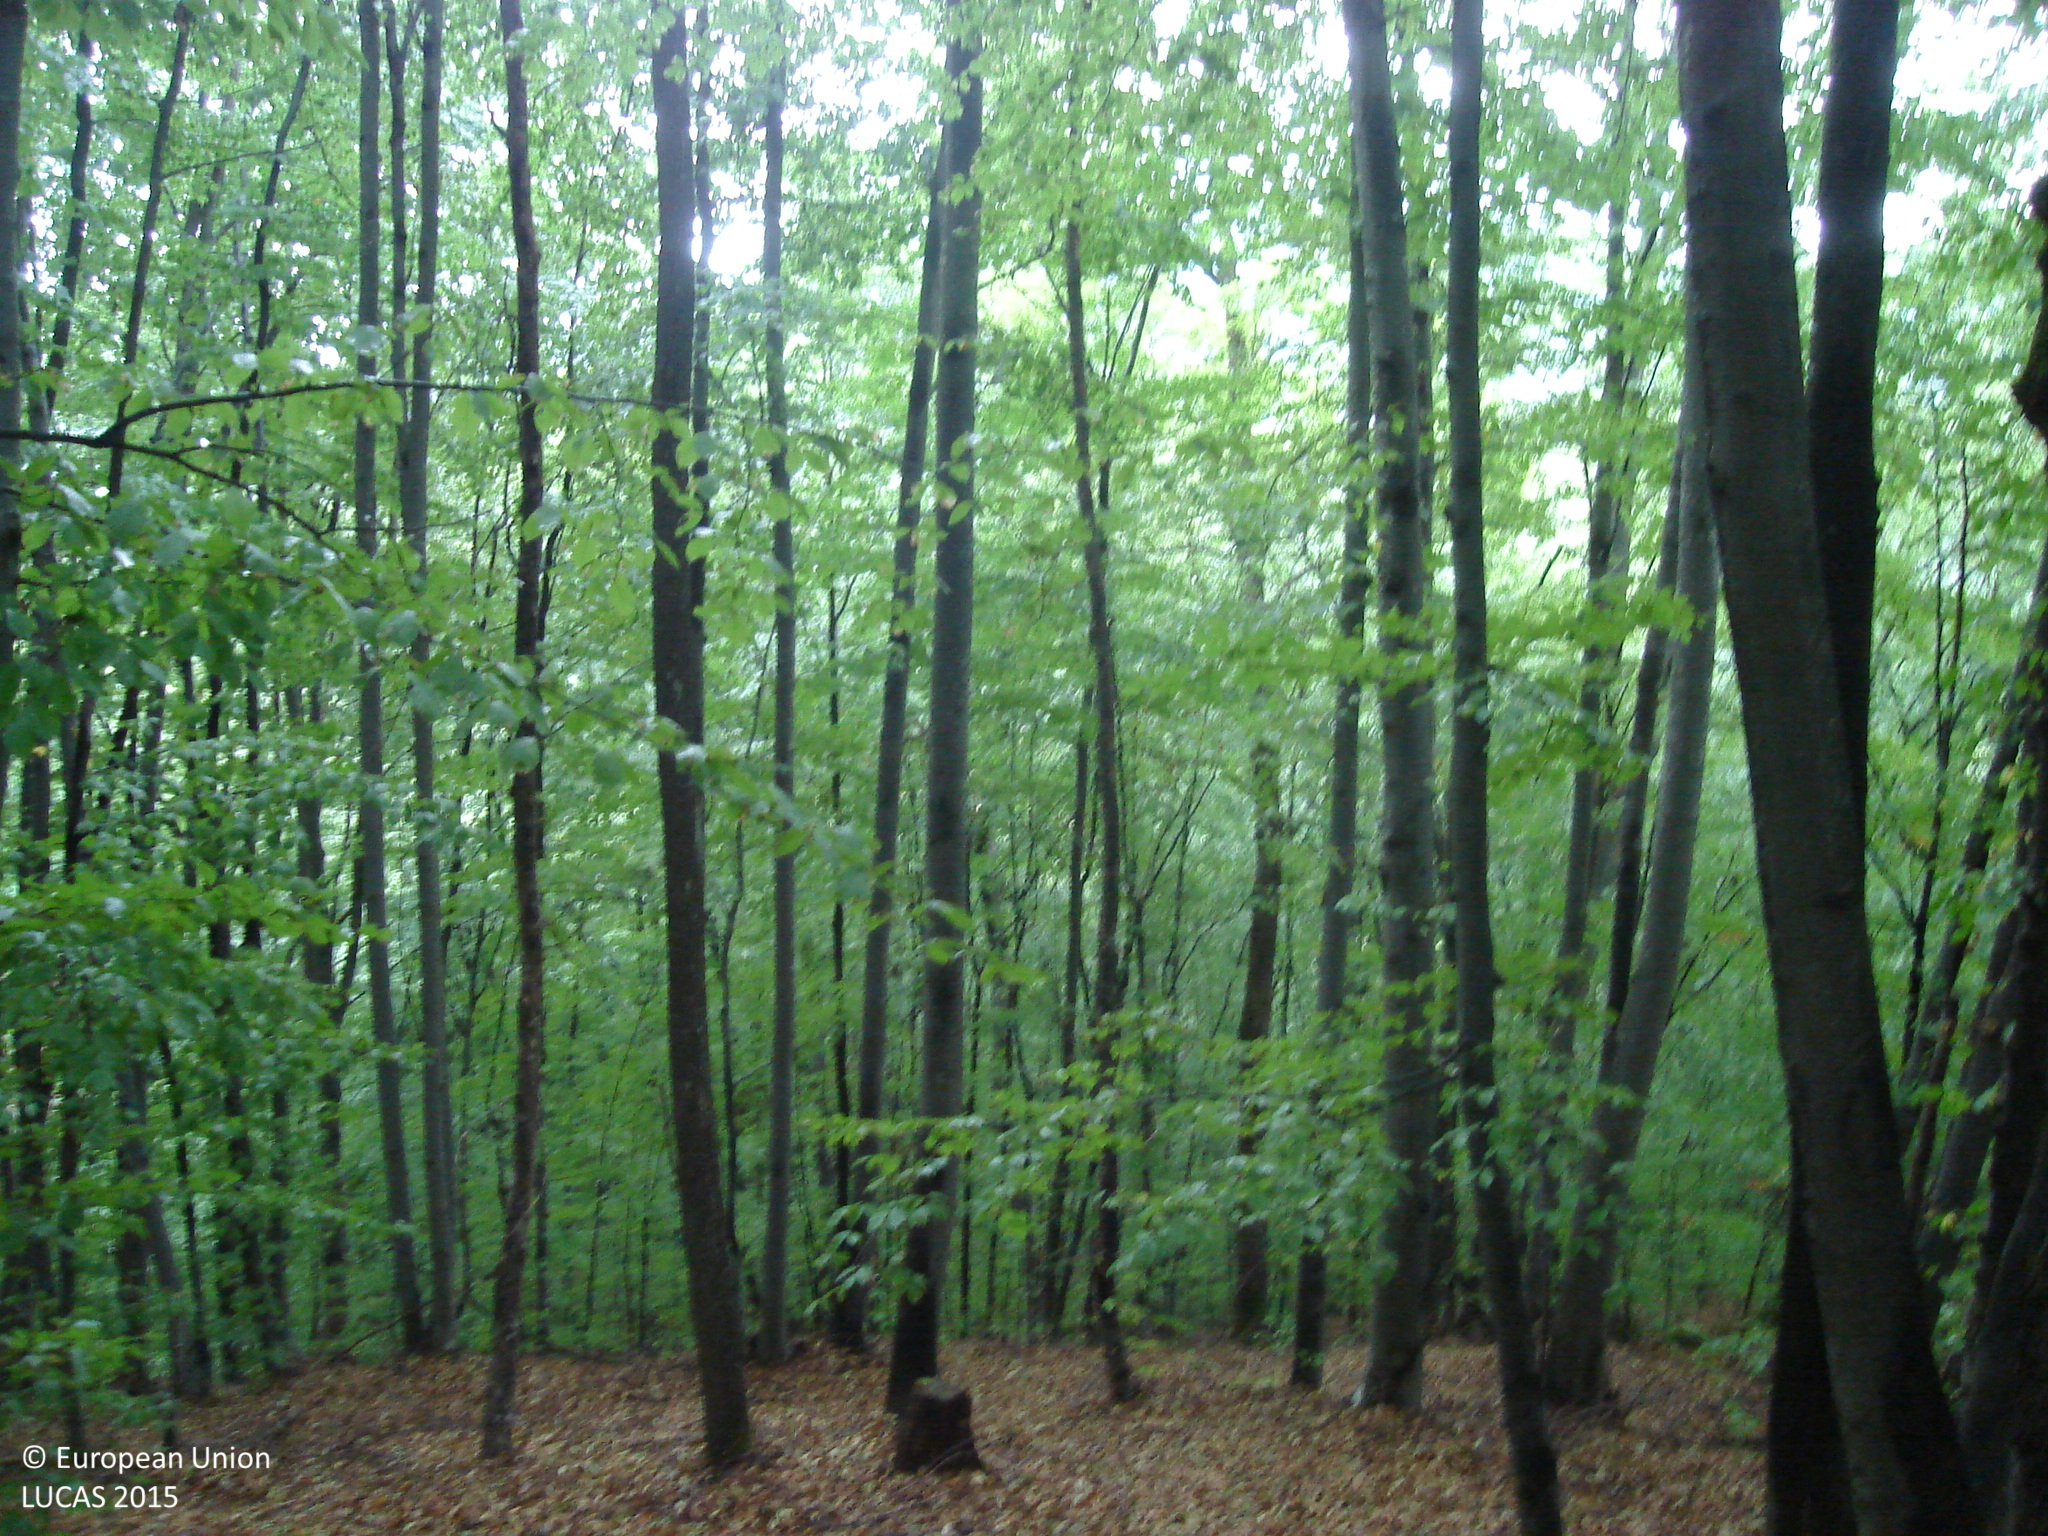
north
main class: Woodland
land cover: Broadleaved woodland
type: beech forest
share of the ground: > 75 %
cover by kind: broadleaved forest trees 80 %, consolidated bare surface 20 %
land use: Forestry
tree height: > 5 m
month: September
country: BG
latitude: 42.8673
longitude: 23.9881
